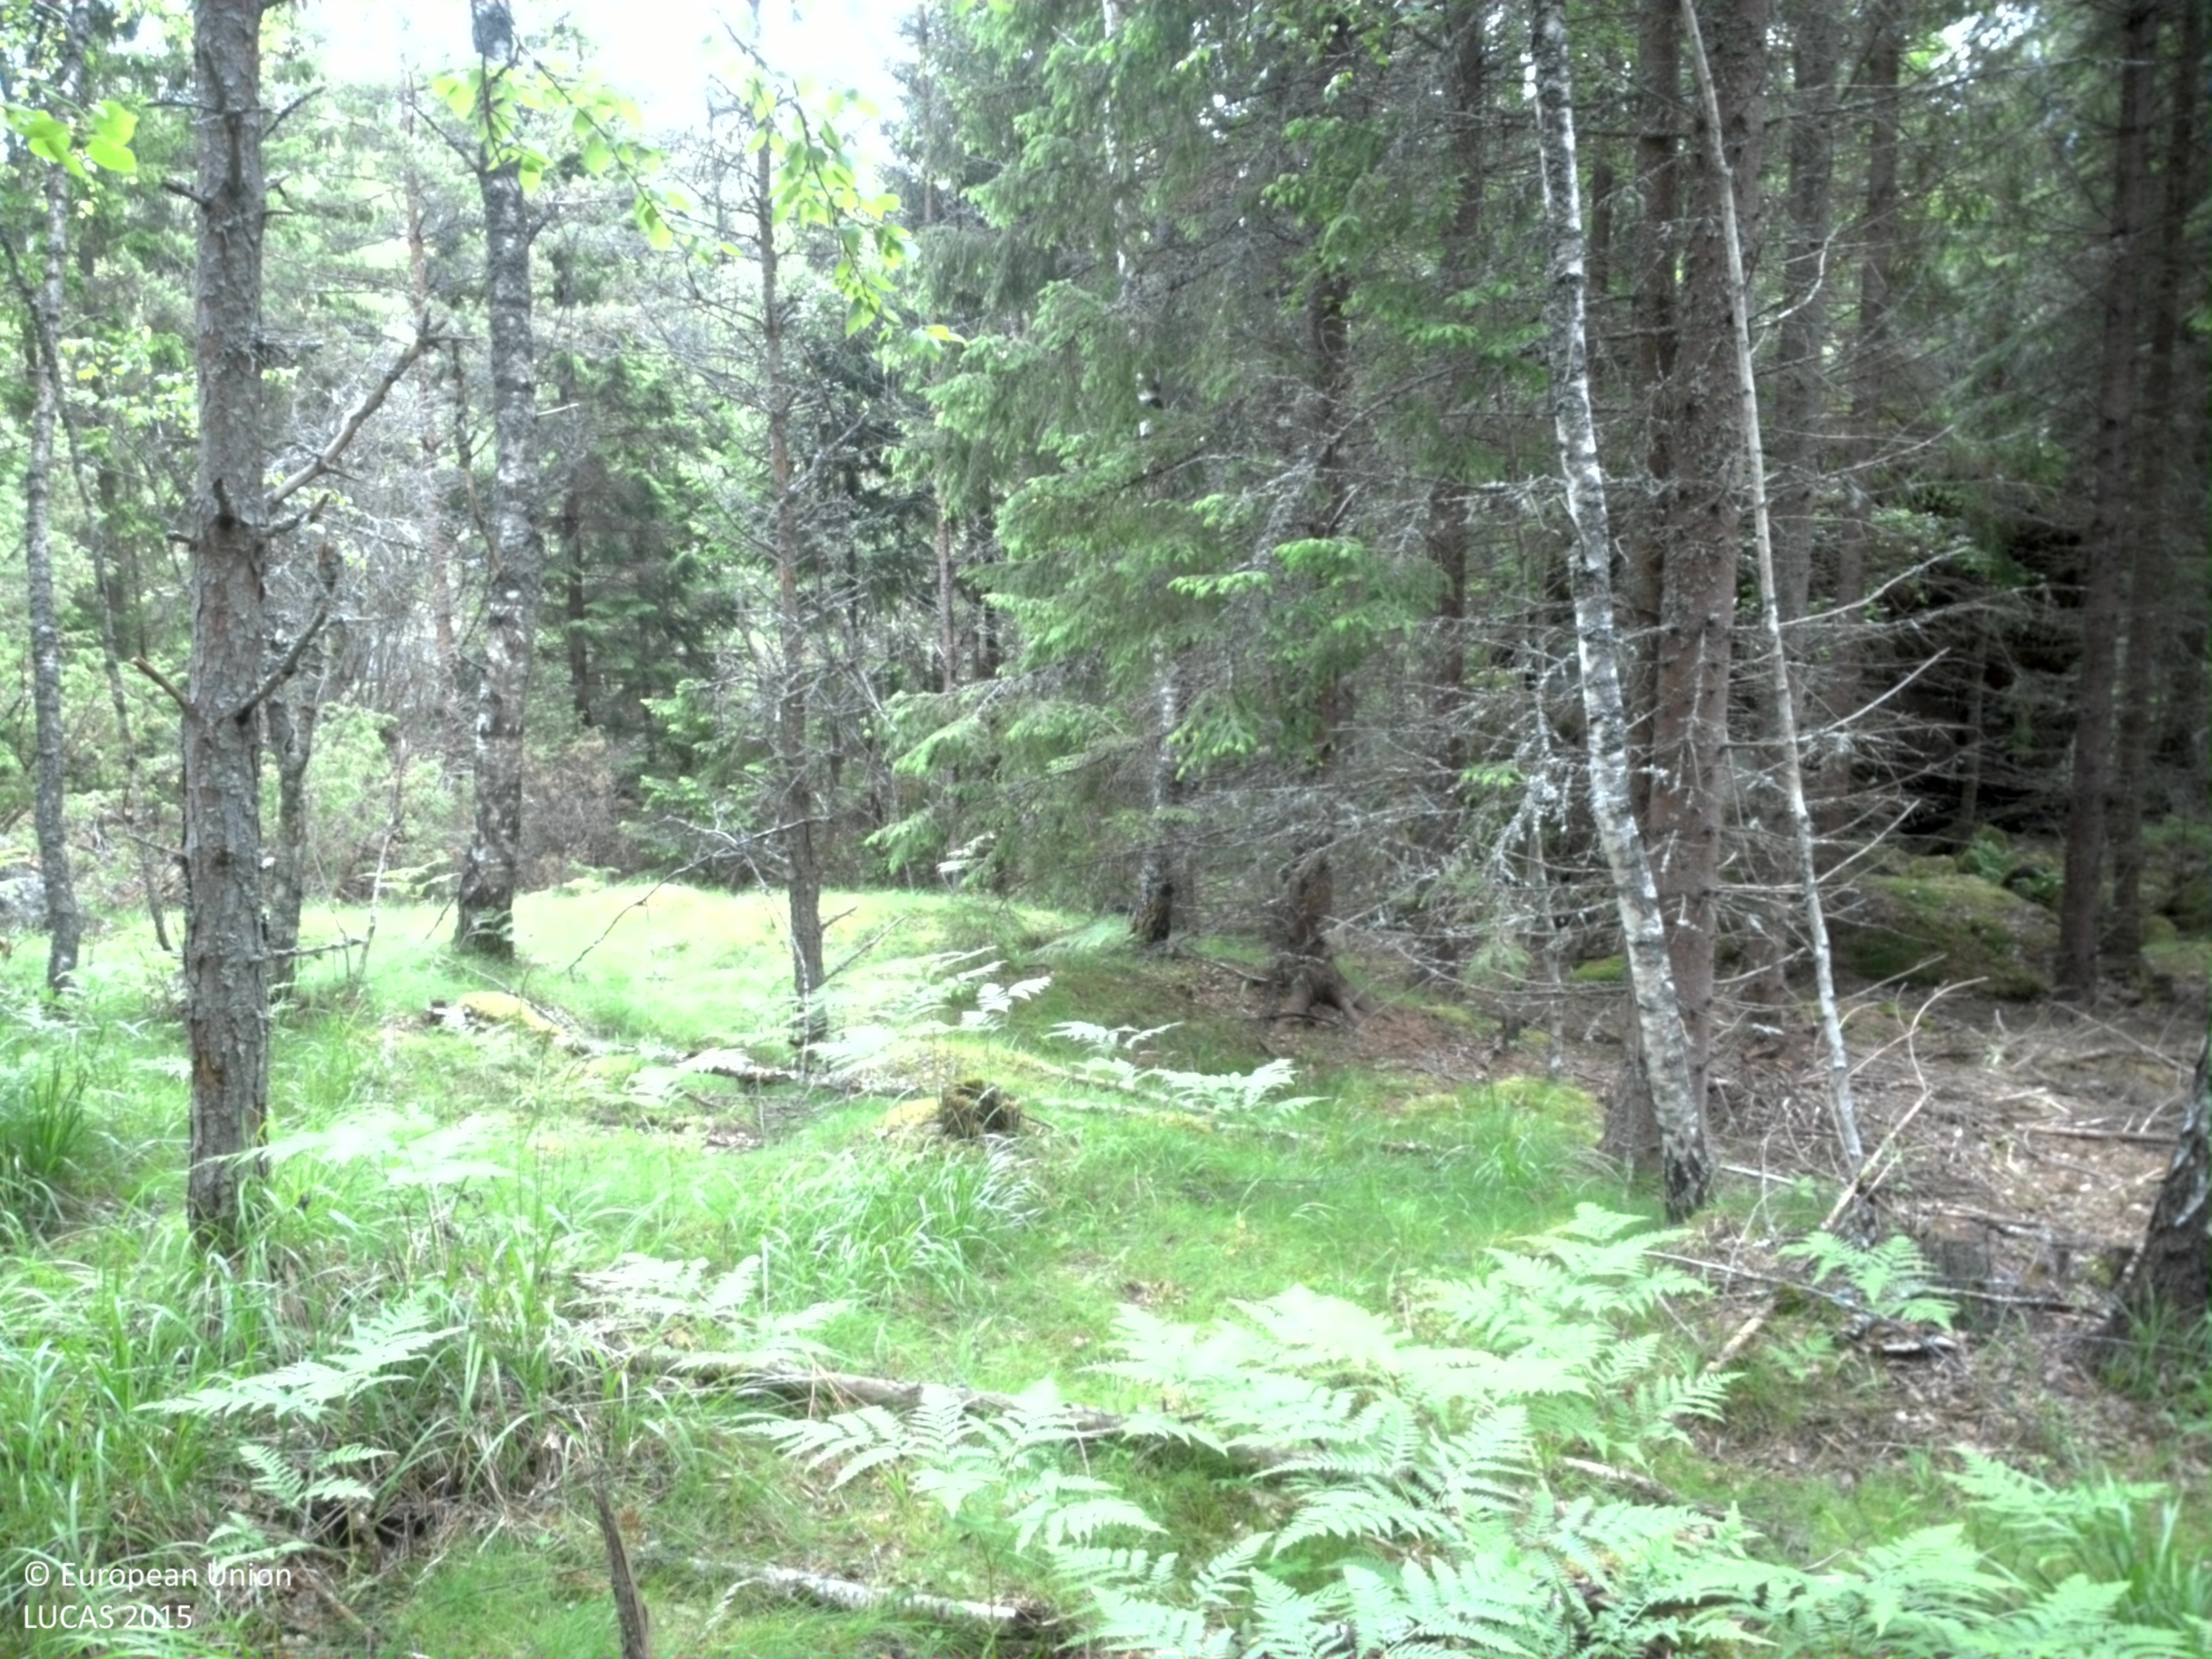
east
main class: Woodland
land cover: Pine dominated mixed woodland
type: boreal forest
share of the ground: 25 - 50 %
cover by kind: herbaceous plants 45 %, coniferous forest trees 25 %, lichens and mosses 20 %, broadleaved forest trees 10 %
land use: Forestry
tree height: > 5 m
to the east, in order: Pine dominated mixed woodland; Spruce dominated mixed woodland; Pine dominated mixed woodland; Spruce dominated coniferous woodland; Pine dominated mixed woodland; Spruce dominated coniferous woodland; Ditches and canals; Spruce dominated coniferous woodland
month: June
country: SE
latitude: 58.6291
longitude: 15.5222
